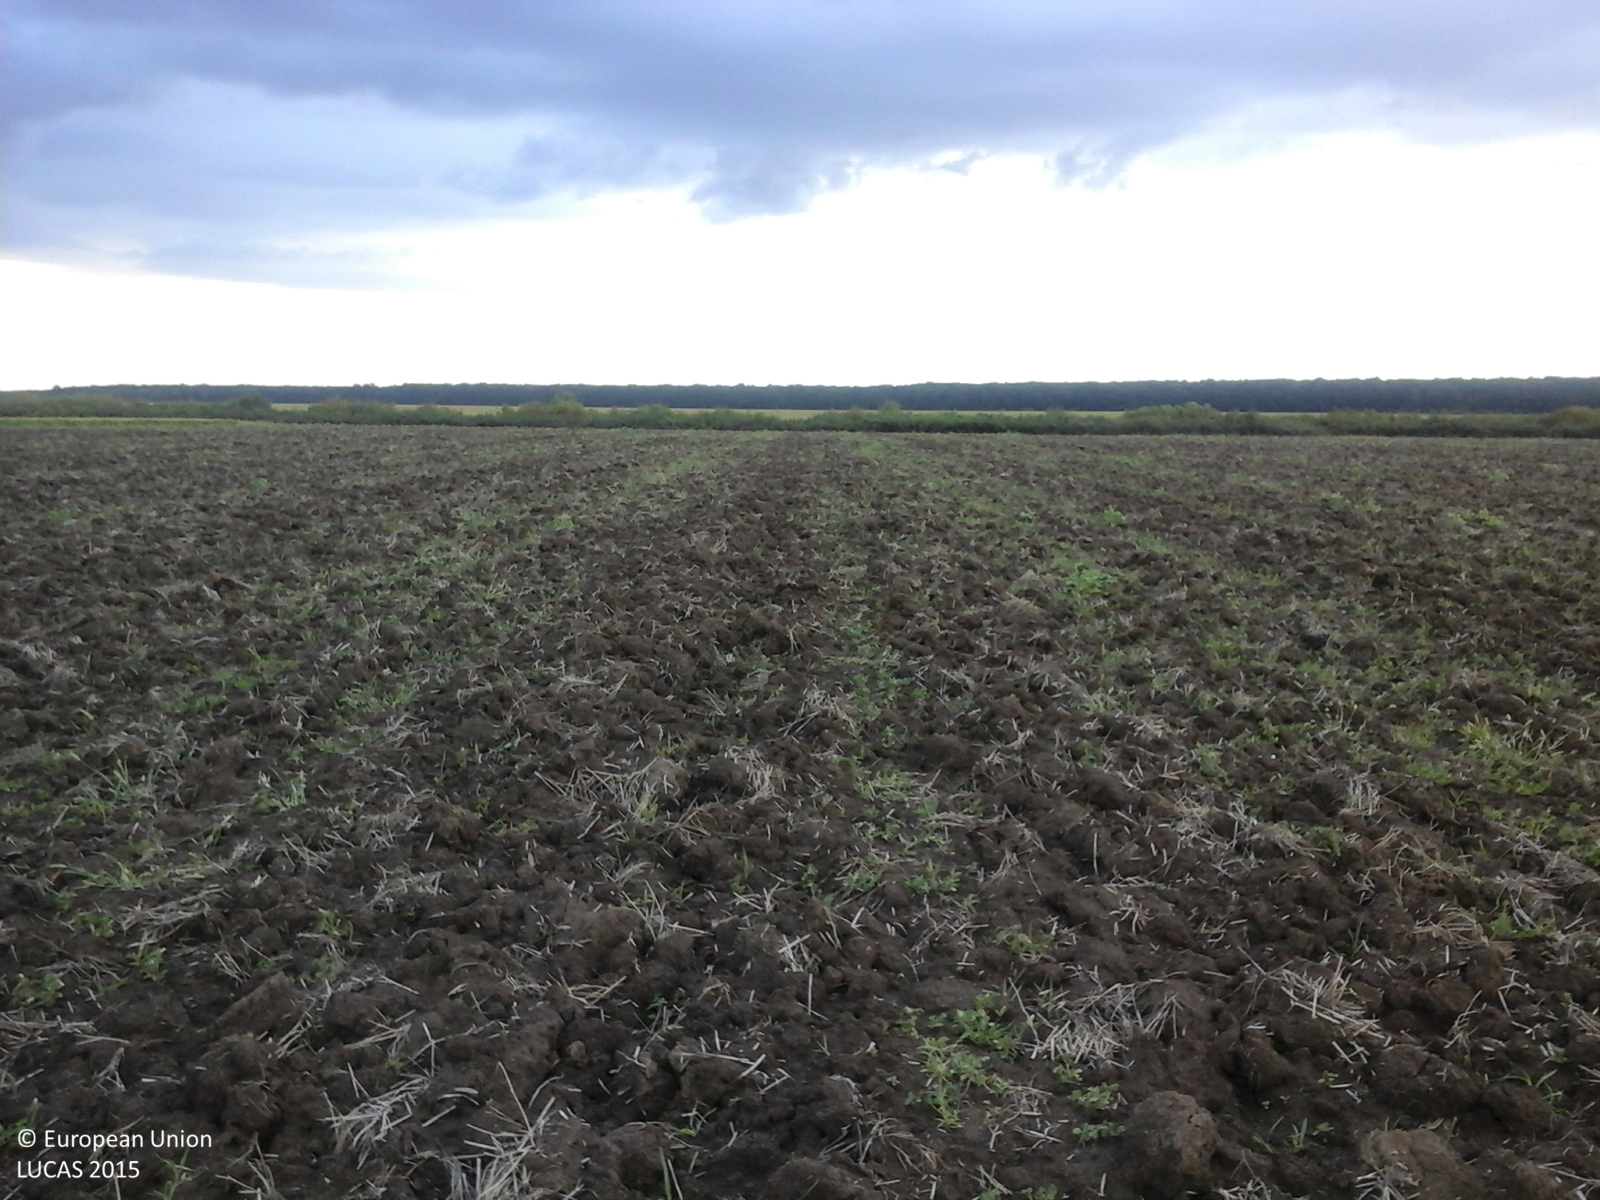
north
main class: Cropland
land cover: Common wheat
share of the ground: < 10 %
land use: Agriculture (excluding fallow land and kitchen gardens)
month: August
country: RO
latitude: 45.6717
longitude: 21.5224
